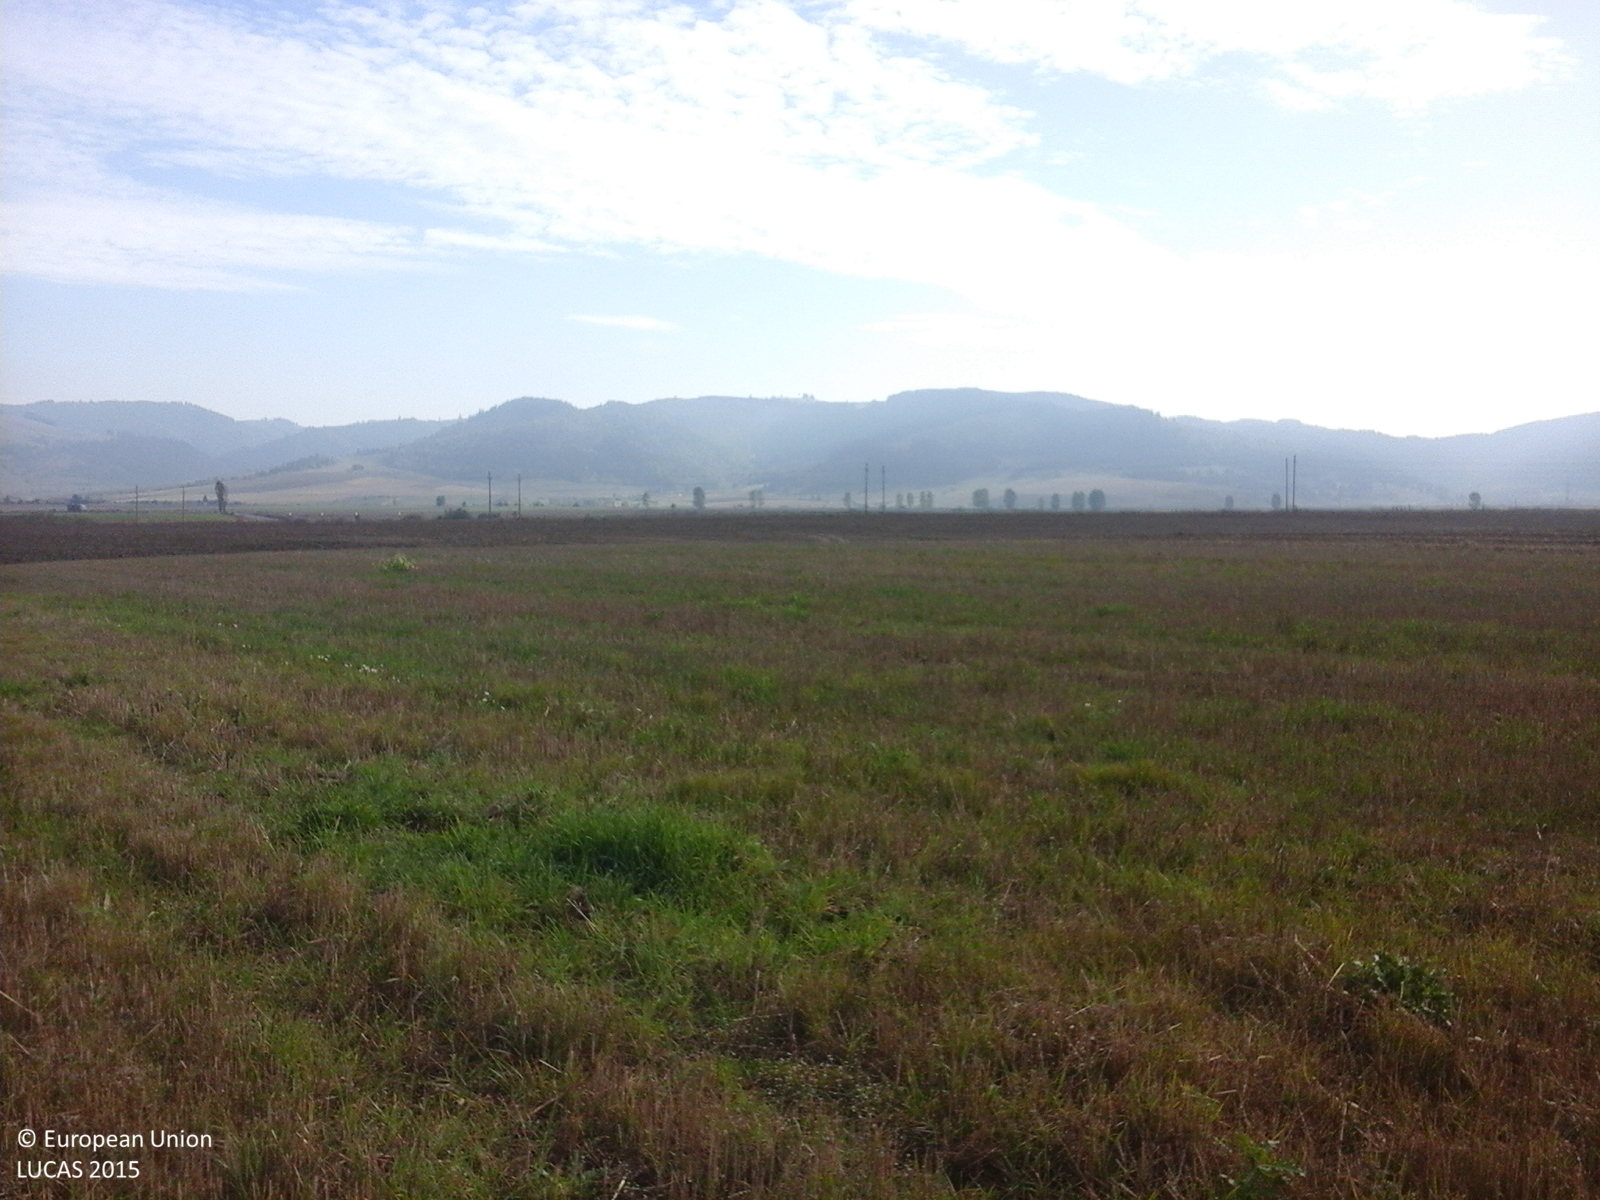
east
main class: Cropland
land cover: Common wheat
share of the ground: > 75 %
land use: Agriculture (excluding fallow land and kitchen gardens)
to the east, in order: Common wheat; Tracks; Potatoes
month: October
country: RO
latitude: 46.2135
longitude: 25.9179
